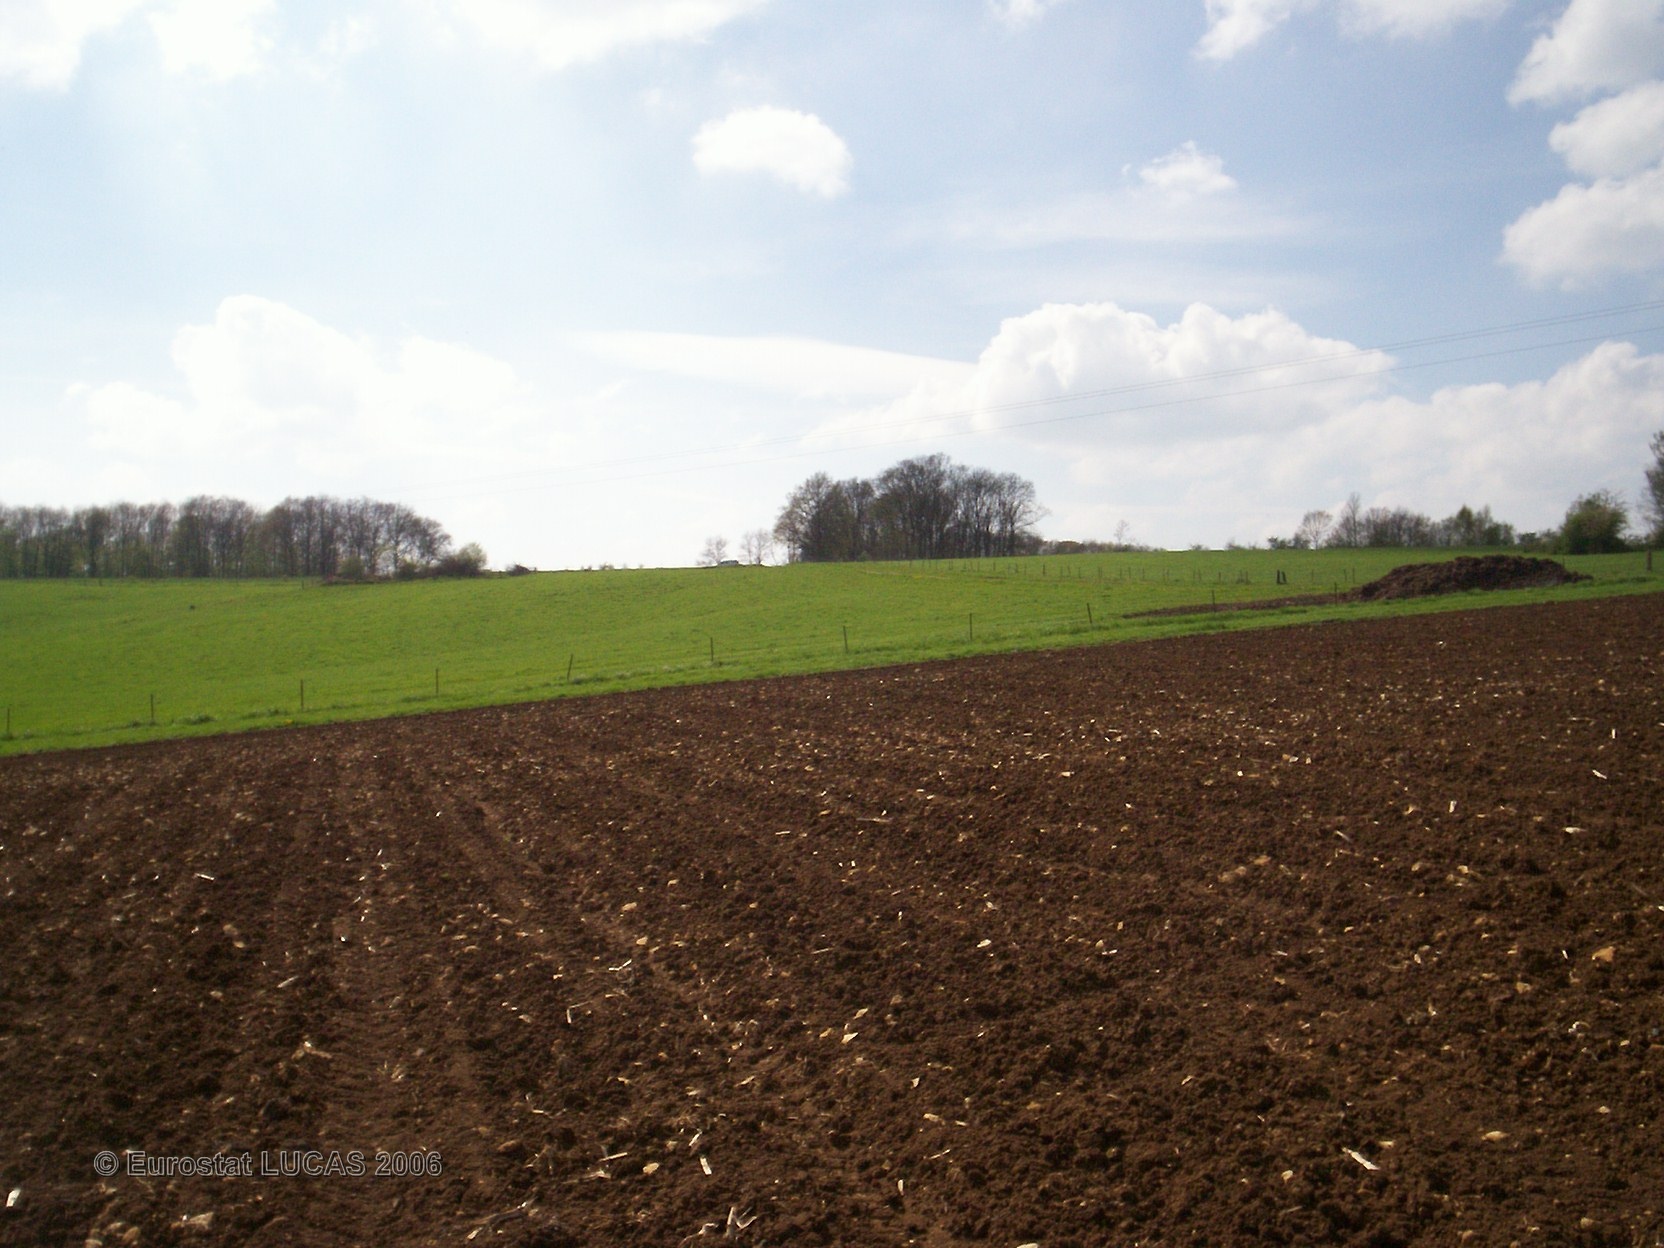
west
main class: Cropland
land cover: Maize
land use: Agriculture (excluding fallow land and kitchen gardens)
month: May
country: FR
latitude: 49.8245
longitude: 4.2824
